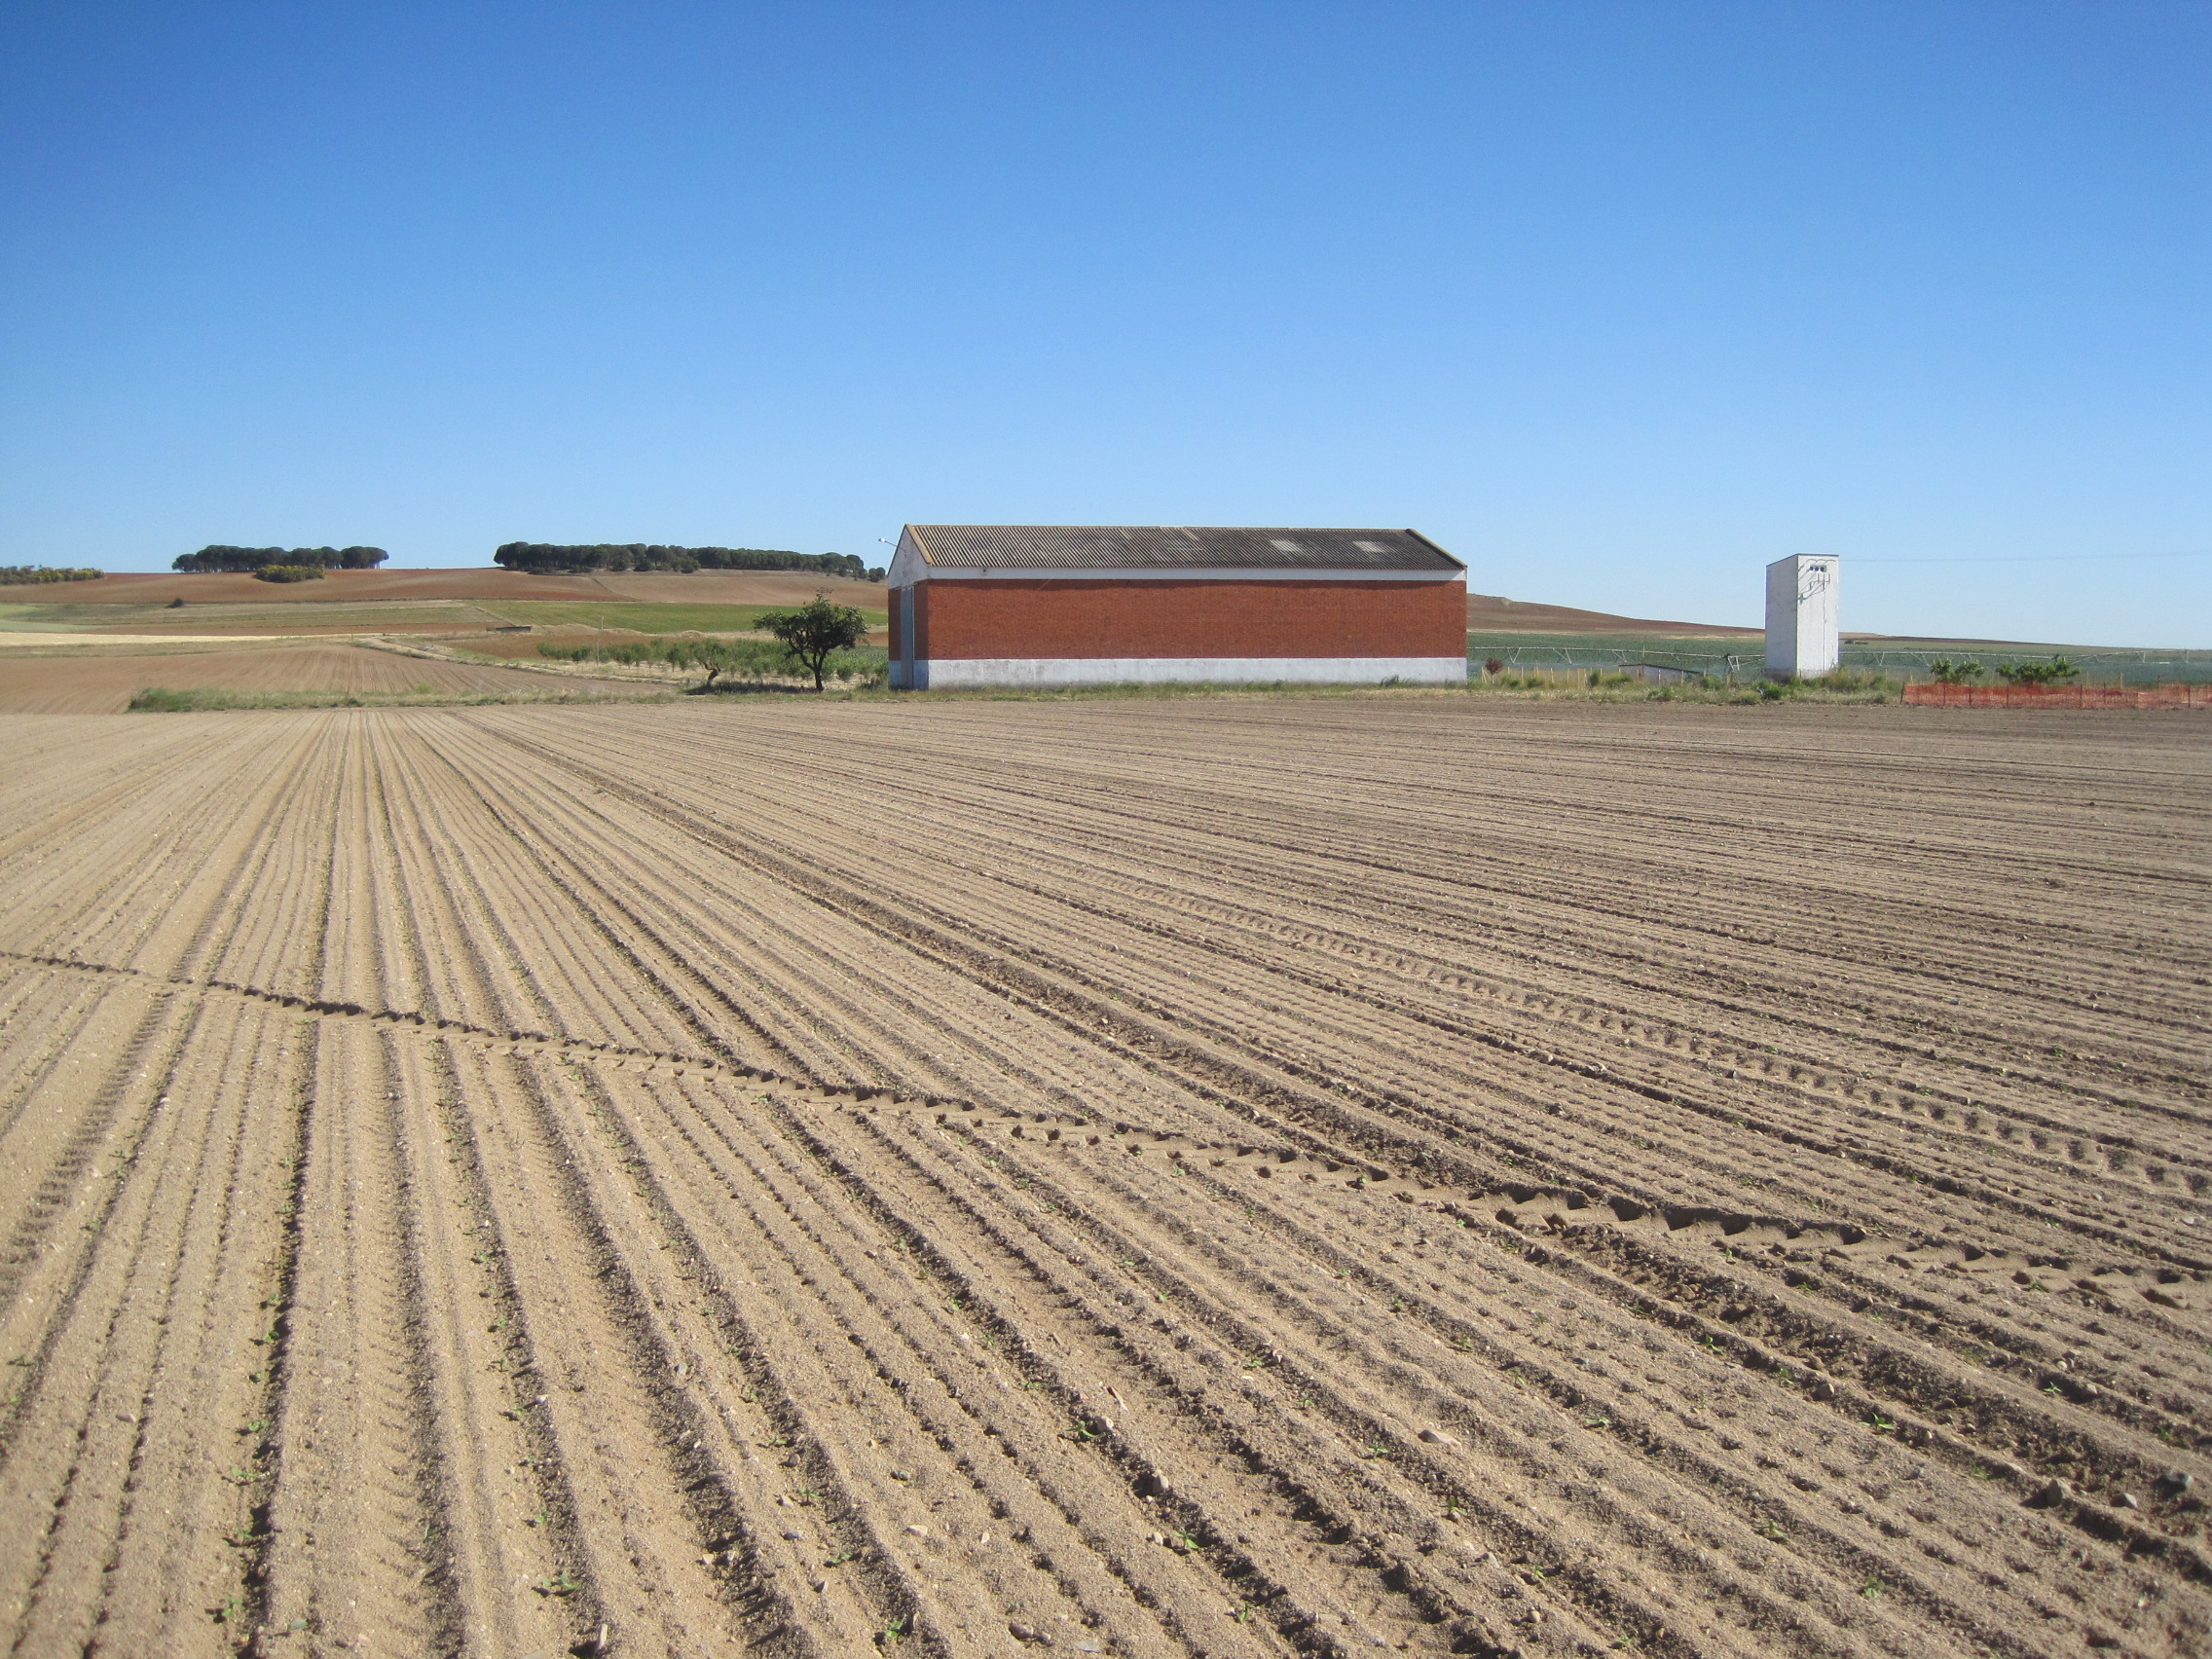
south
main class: Cropland
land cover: Sunflower
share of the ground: < 10 %
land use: Agriculture (excluding fallow land and kitchen gardens)
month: May
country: ES
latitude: 41.3288
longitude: -5.1145
